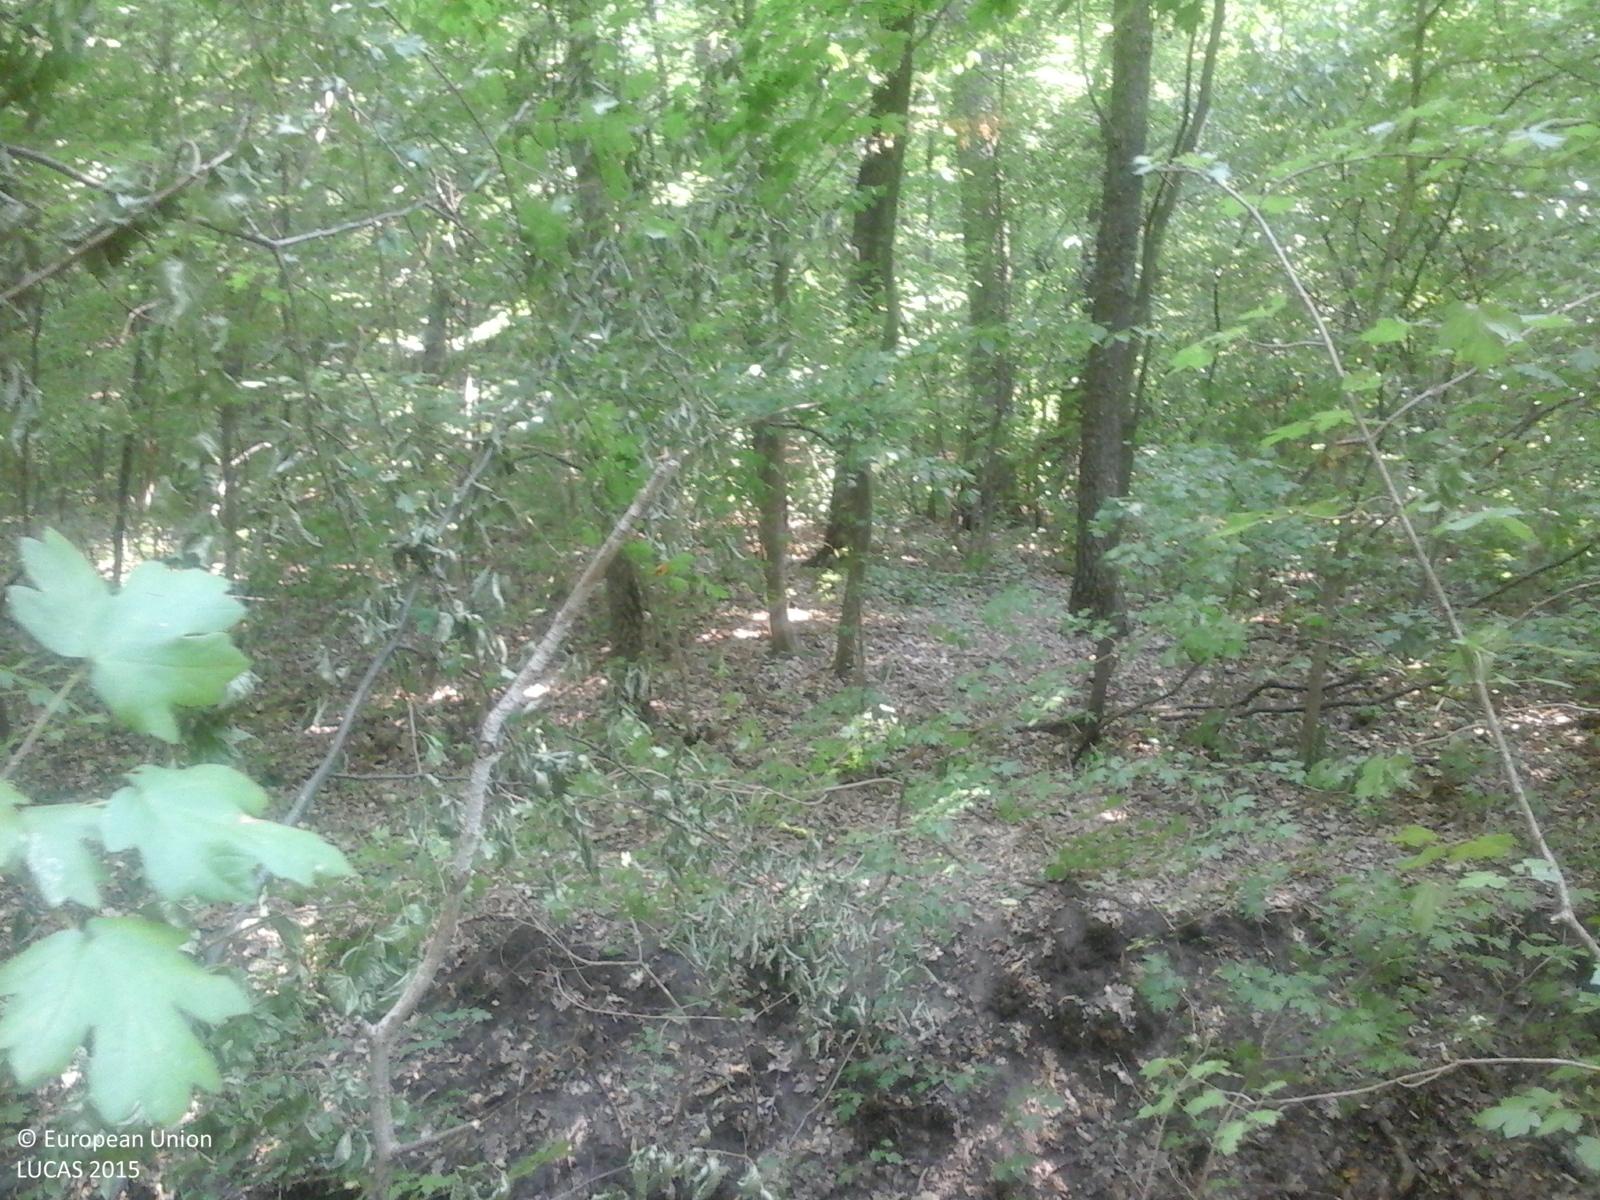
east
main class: Woodland
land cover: Broadleaved woodland
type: acidophilous oak and oak-birch forest
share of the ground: > 75 %
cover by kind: broadleaved forest trees 100 %
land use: Forestry
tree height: > 5 m
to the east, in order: Broadleaved woodland; Tracks; Broadleaved woodland
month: July
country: RO
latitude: 46.3910
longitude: 27.5770
